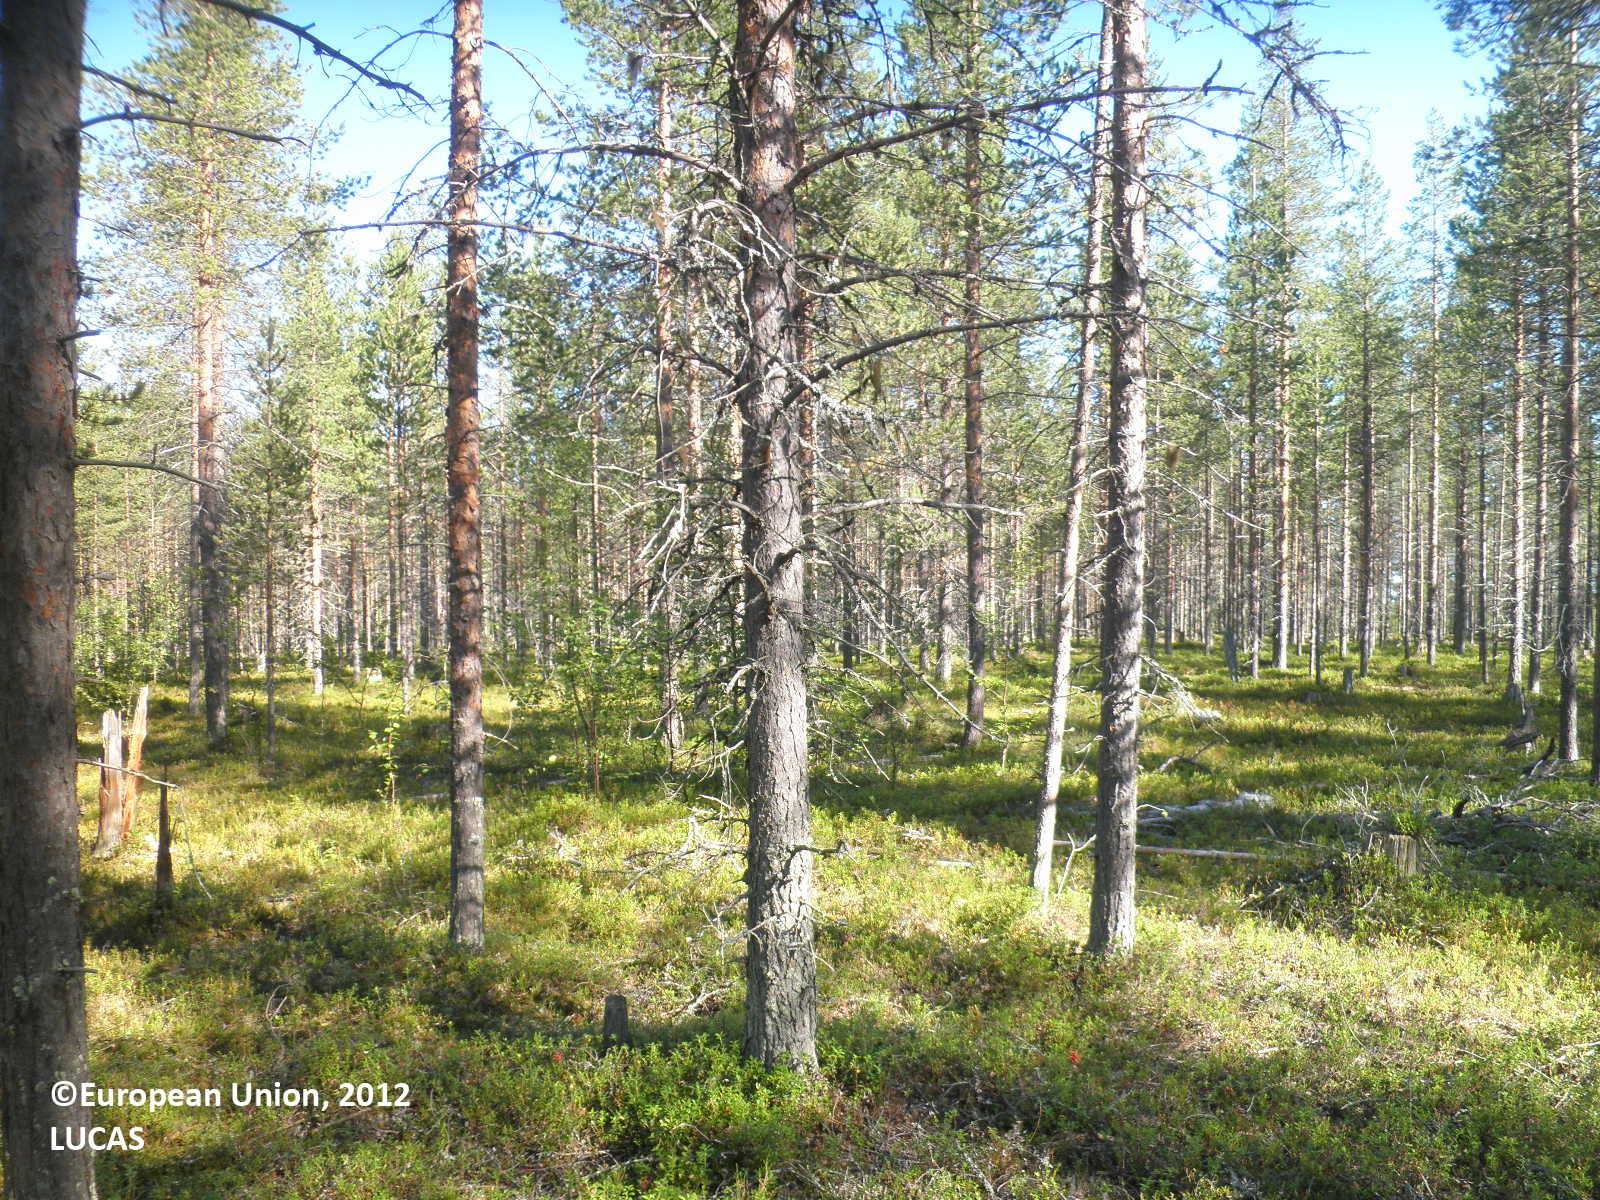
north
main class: Woodland
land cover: Pine dominated coniferous woodland
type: boreal forest
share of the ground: 50 - 75 %
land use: Forestry
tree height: > 5 m
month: August
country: FI
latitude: 67.6908
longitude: 25.4601
